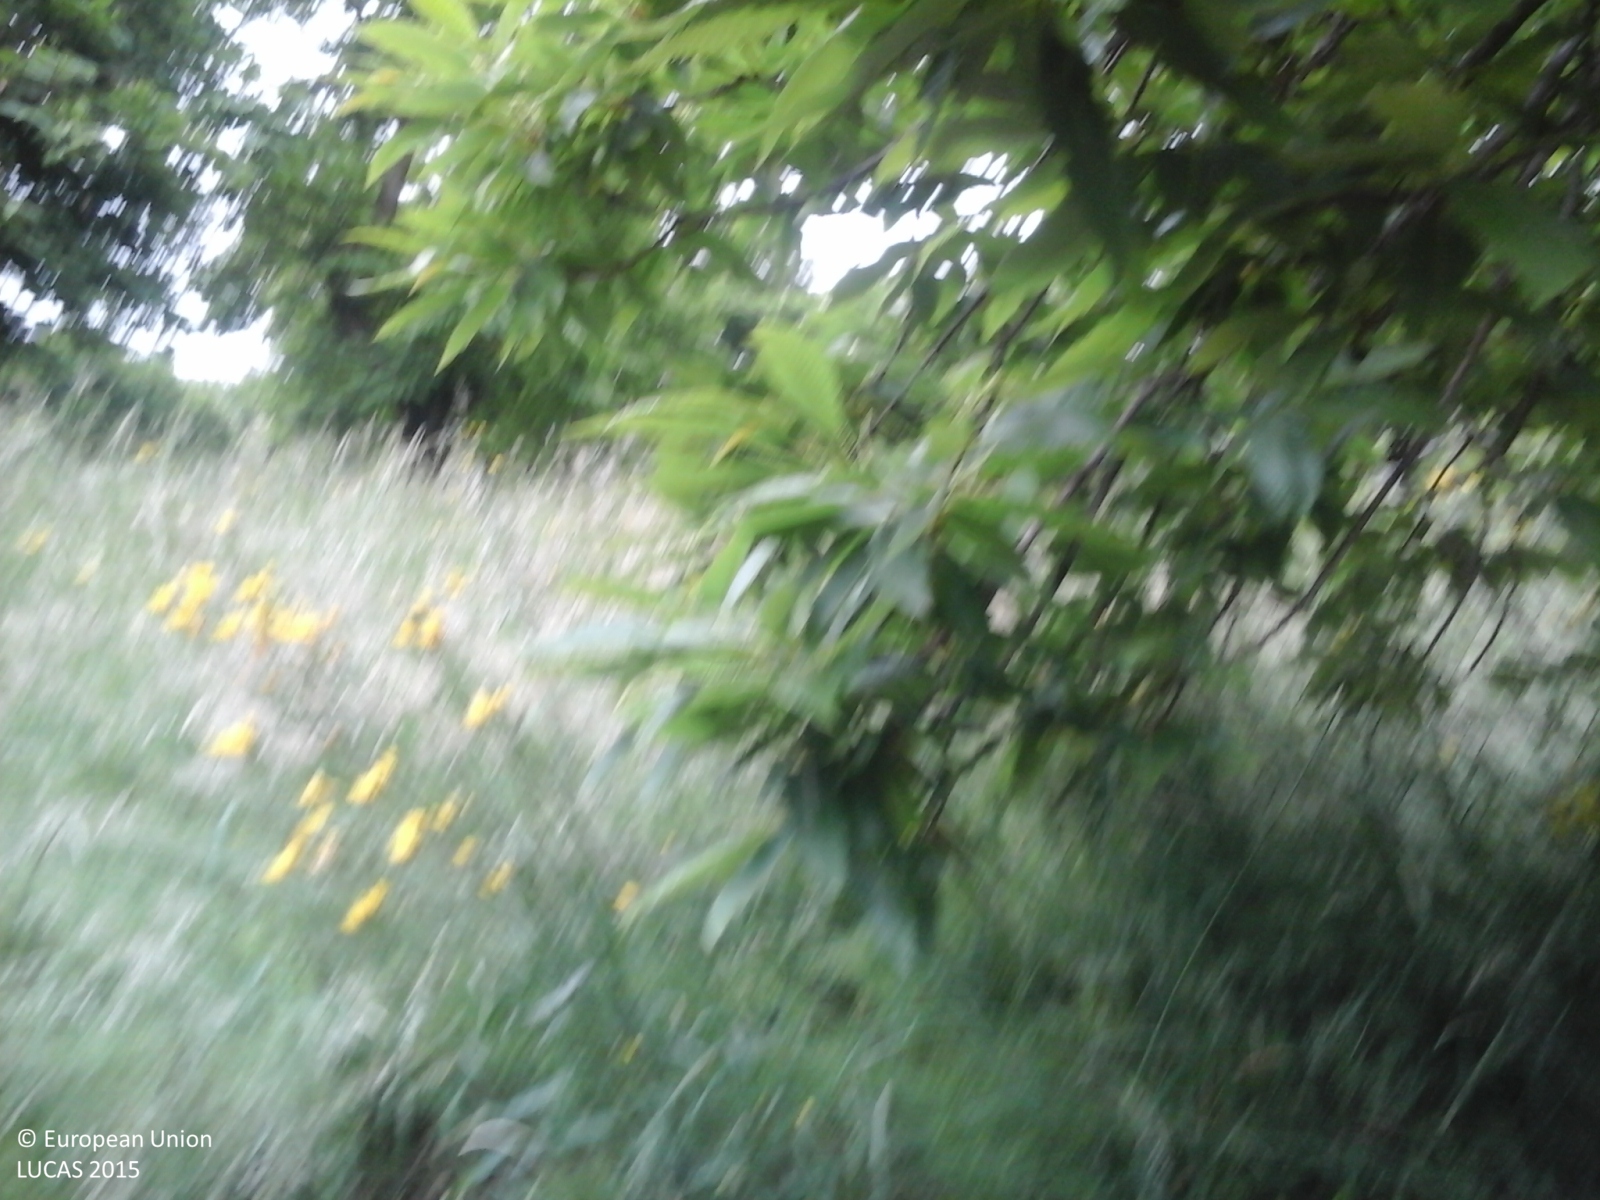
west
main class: Cropland
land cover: Apple fruit
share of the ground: 25 - 50 %
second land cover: Grassland without tree/shrub cover
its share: > 75 %
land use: Agriculture (excluding fallow land and kitchen gardens)
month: May
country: IT
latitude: 45.8244
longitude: 10.9639
